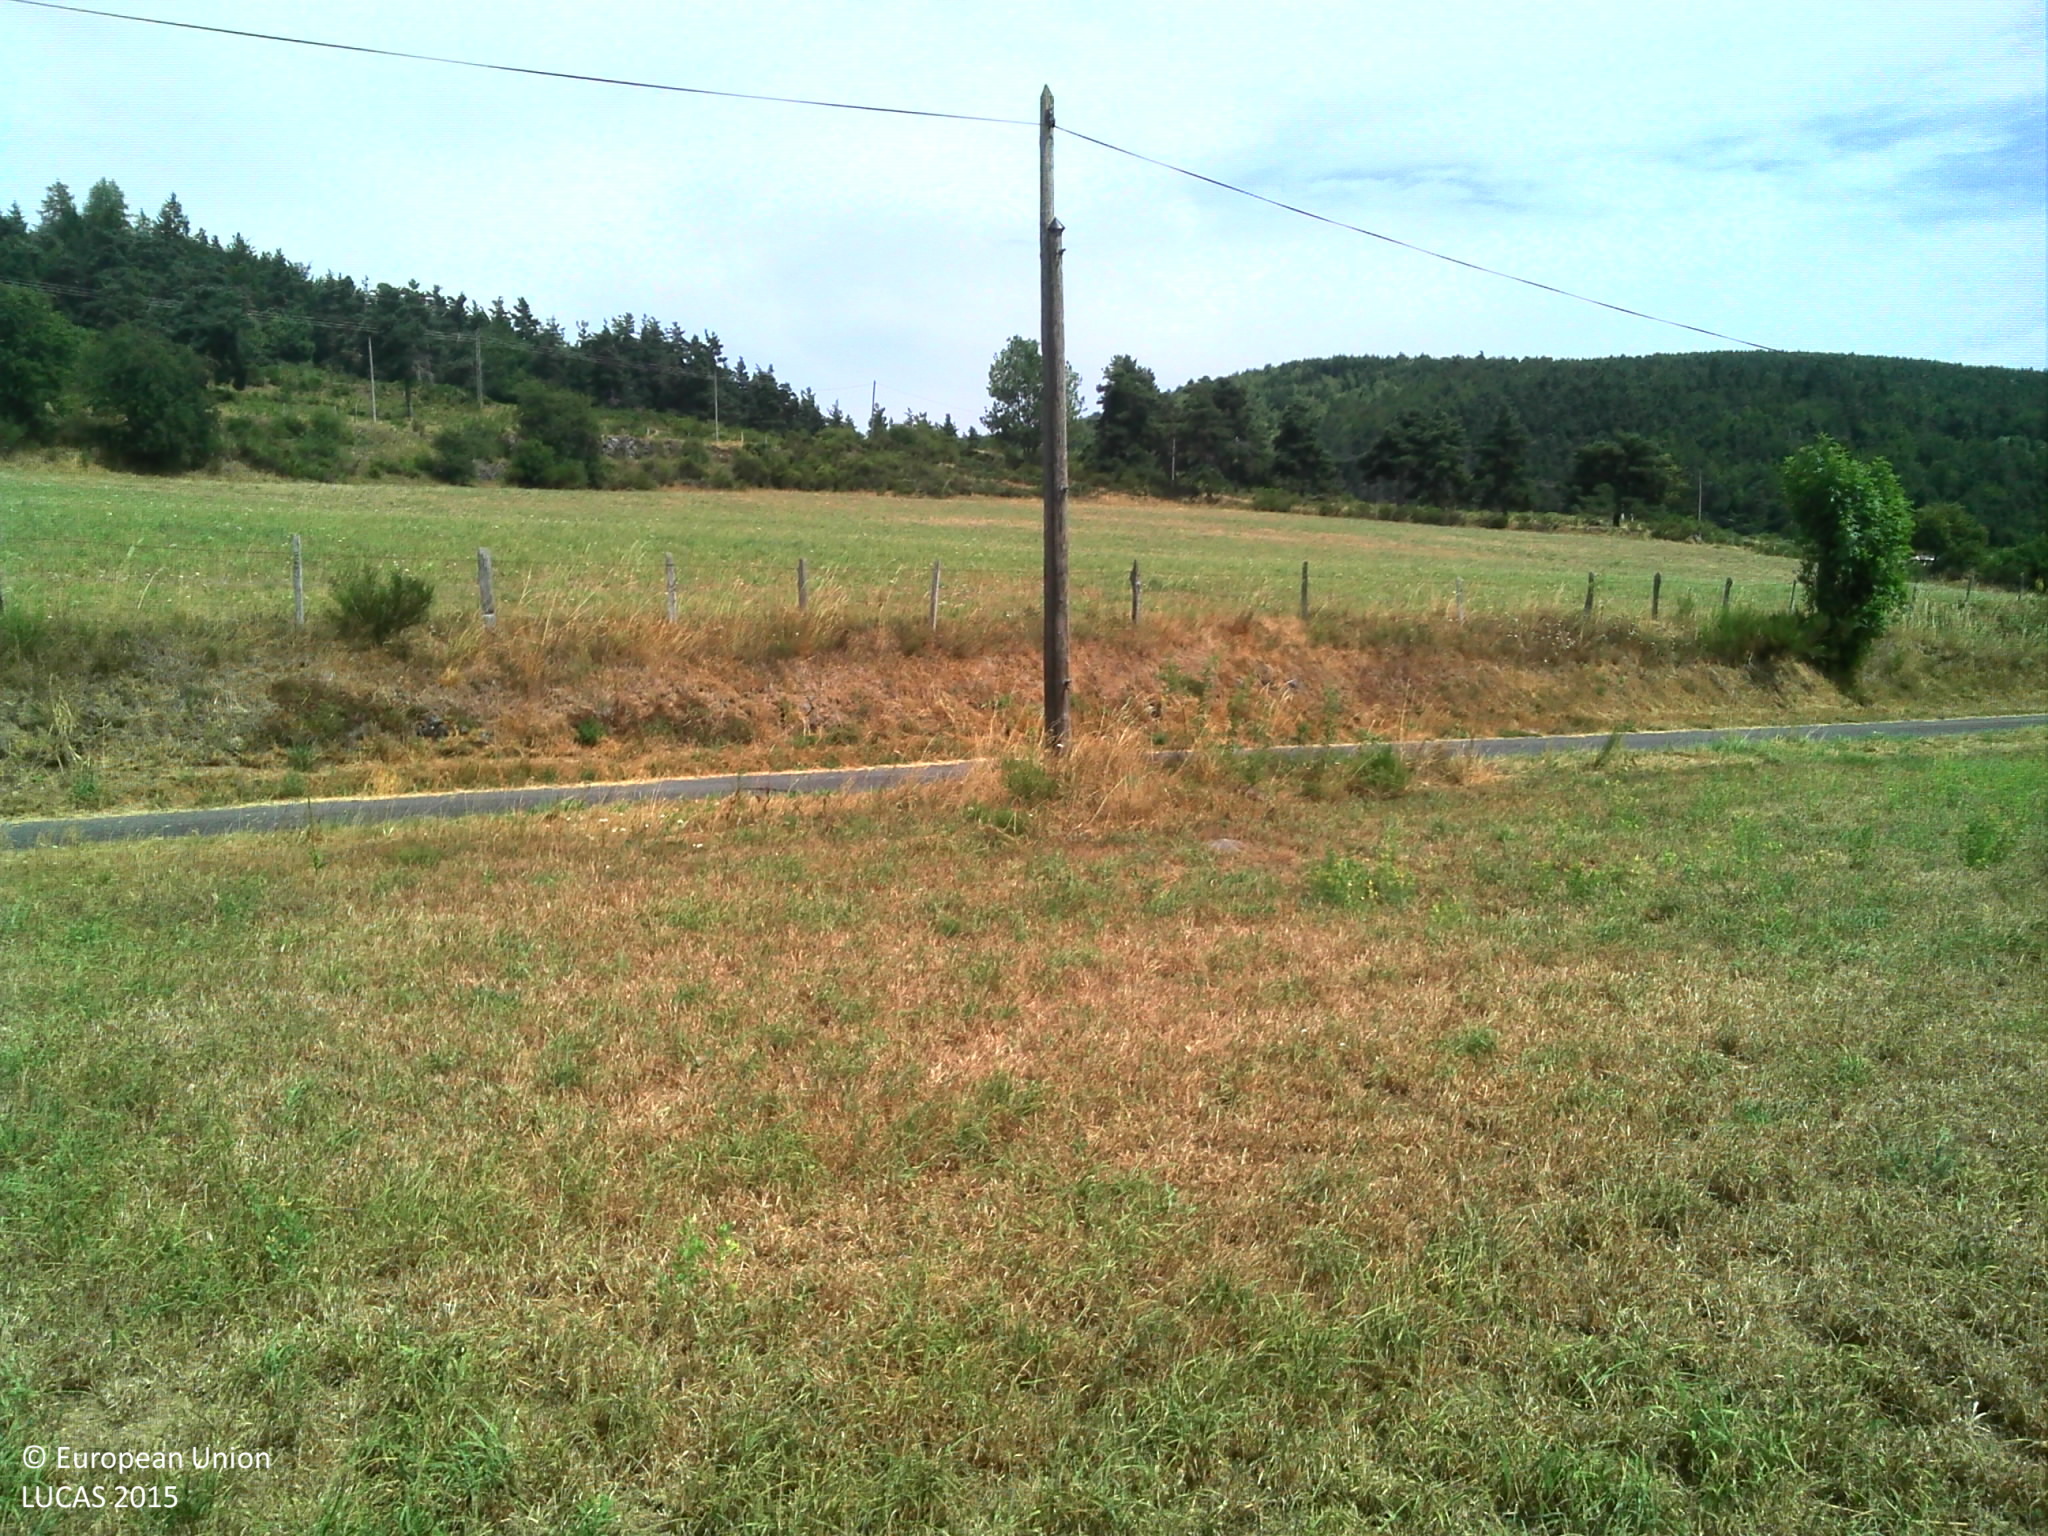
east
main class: Grassland
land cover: Grassland without tree/shrub cover
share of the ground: > 75 %
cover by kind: herbaceous plants 100 %
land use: Agriculture (excluding fallow land and kitchen gardens)
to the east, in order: Grassland without tree/shrub cover; Electric lines; Grass margins; Paved roads, cycling and walking lanes; Grass margins; Dry stone walls; Fences; Grassland without tree/shrub cover; Fences; Electric lines; Pine dominated coniferous woodland; Shrubland without tree cover; Grassland without tree/shrub cover
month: July
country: FR
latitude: 44.6780
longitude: 3.9121
